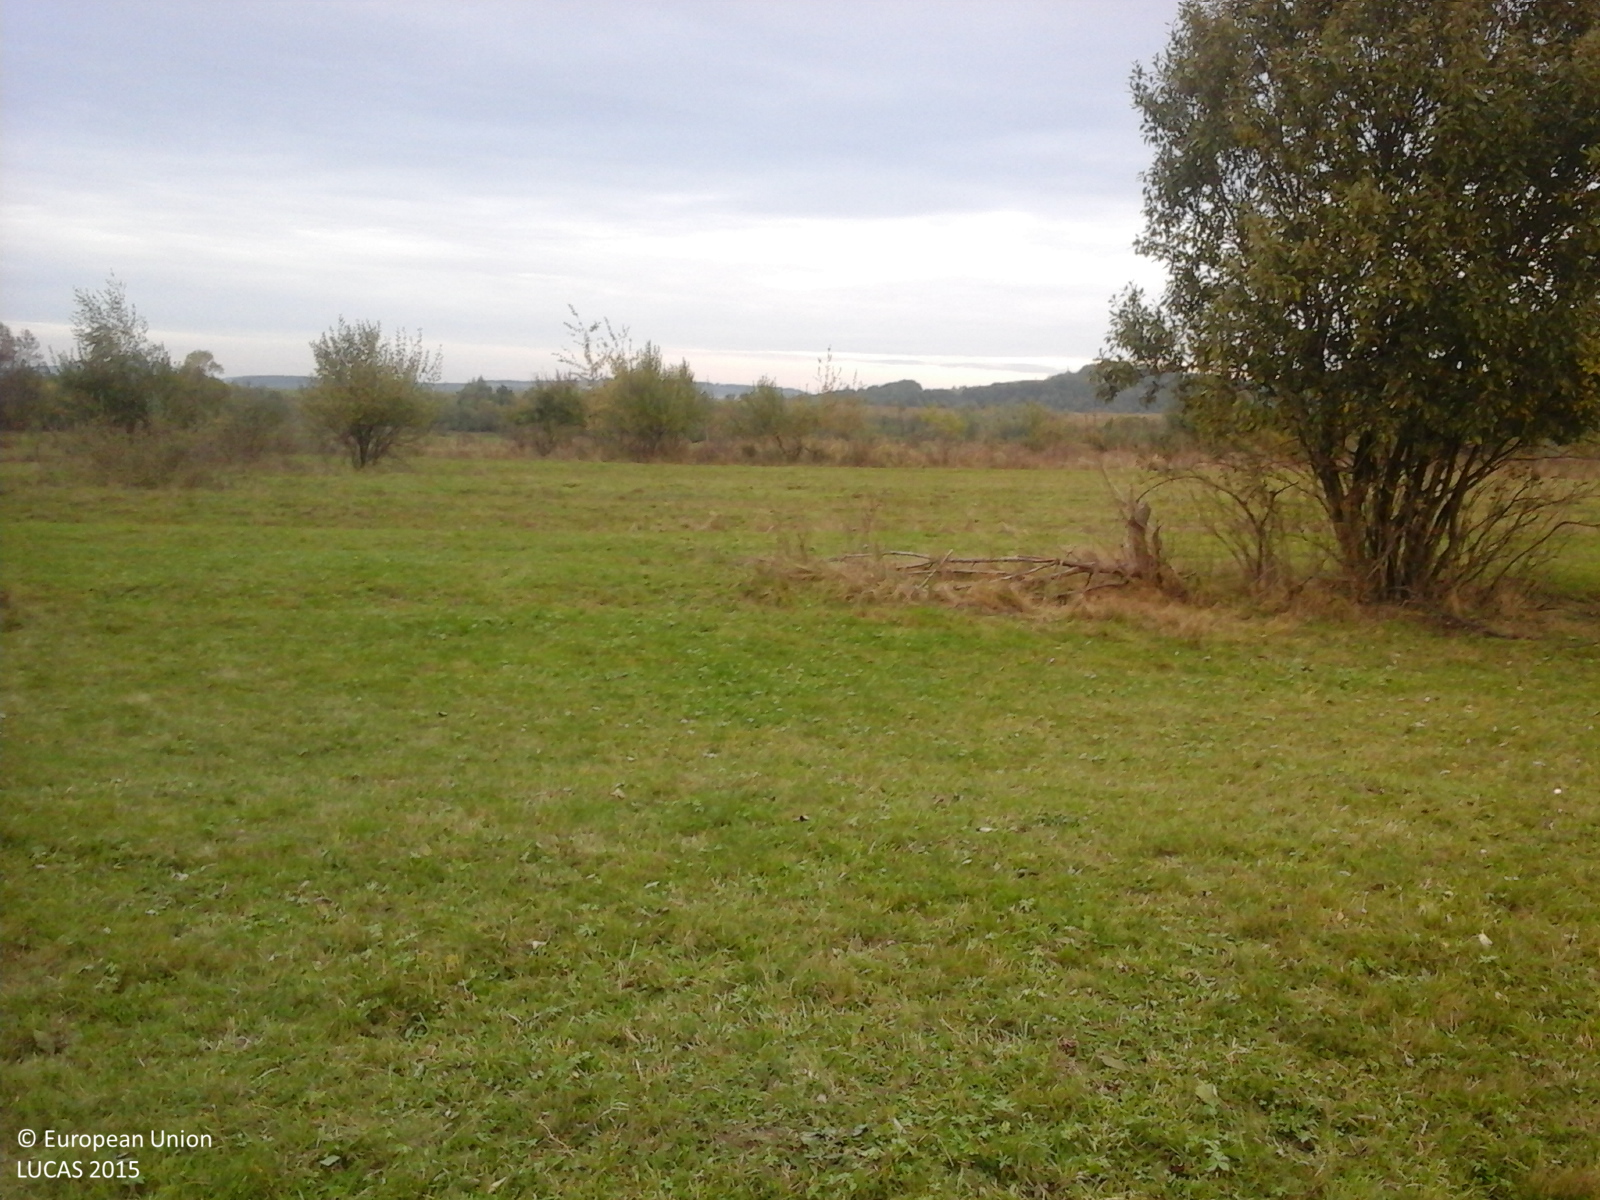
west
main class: Grassland
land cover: Grassland without tree/shrub cover
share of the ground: > 75 %
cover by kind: herbaceous plants 100 %
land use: Agriculture (excluding fallow land and kitchen gardens)
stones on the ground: < 10 %
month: October
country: RO
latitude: 45.7587
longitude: 25.1503
